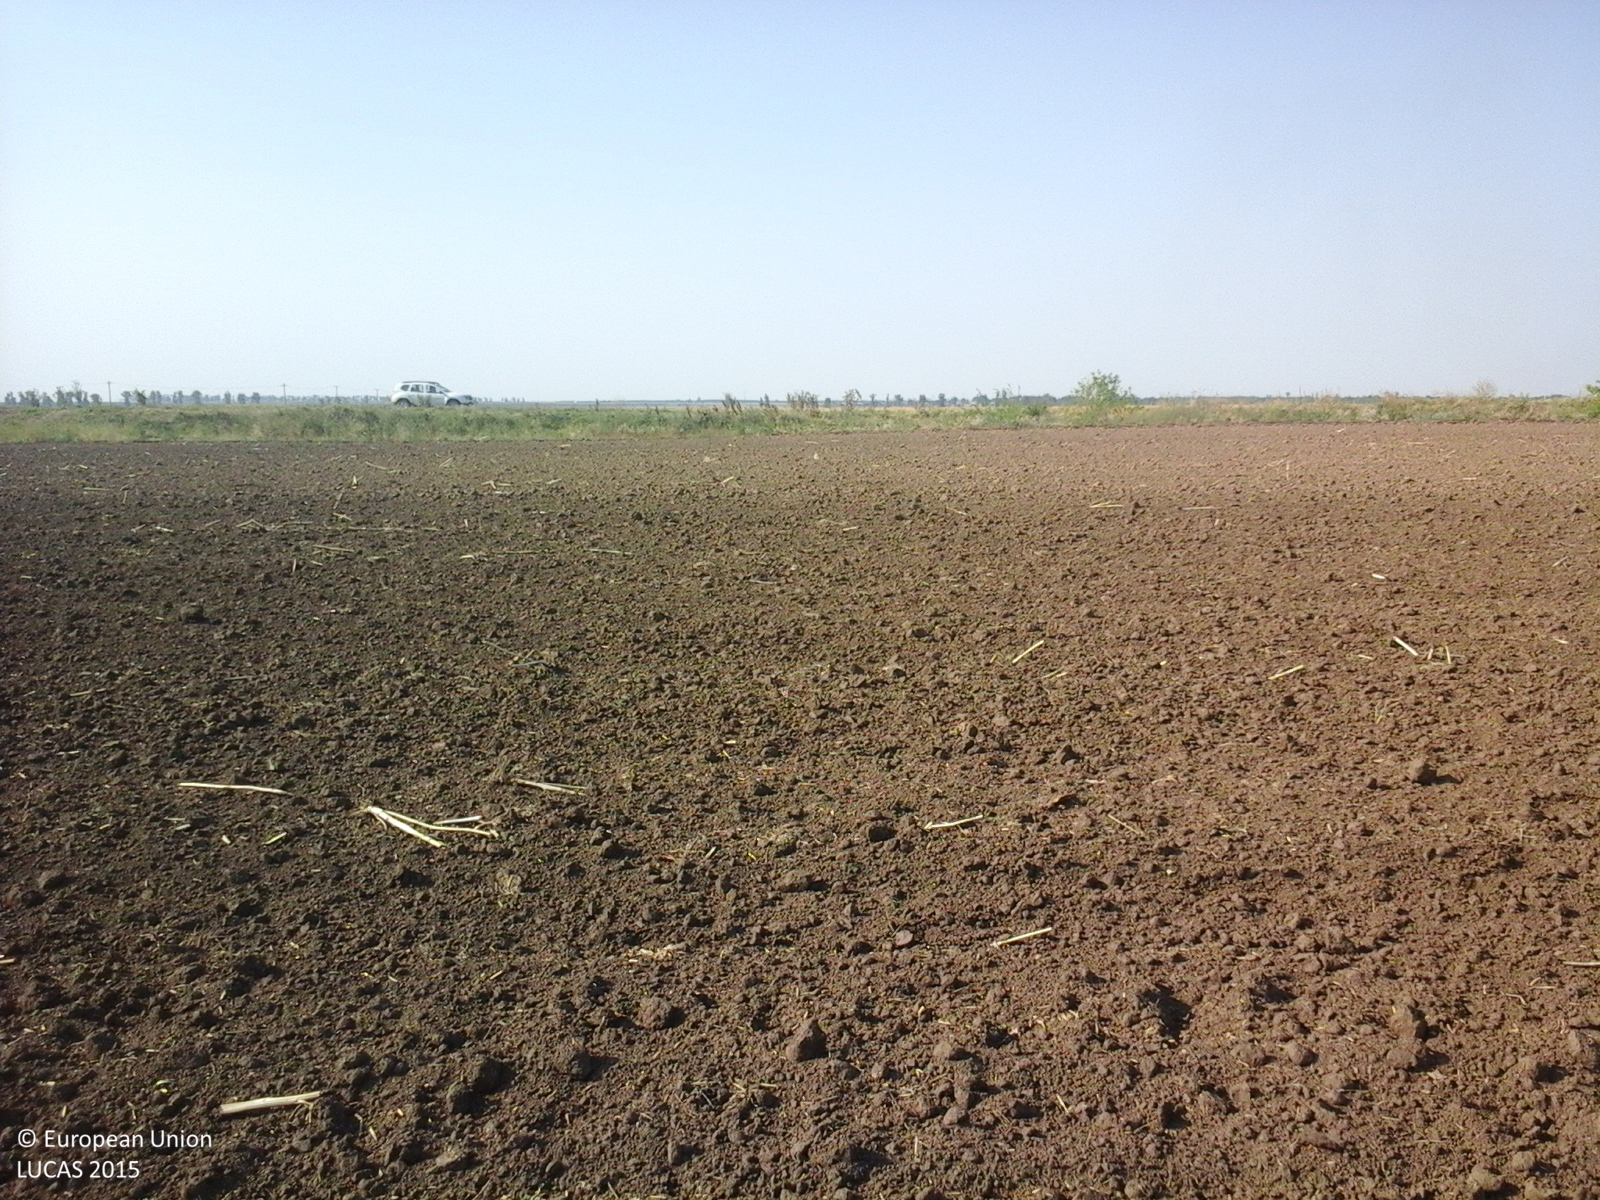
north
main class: Cropland
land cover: Common wheat
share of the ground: < 10 %
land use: Agriculture (excluding fallow land and kitchen gardens)
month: July
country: RO
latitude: 44.6997
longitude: 27.3418
